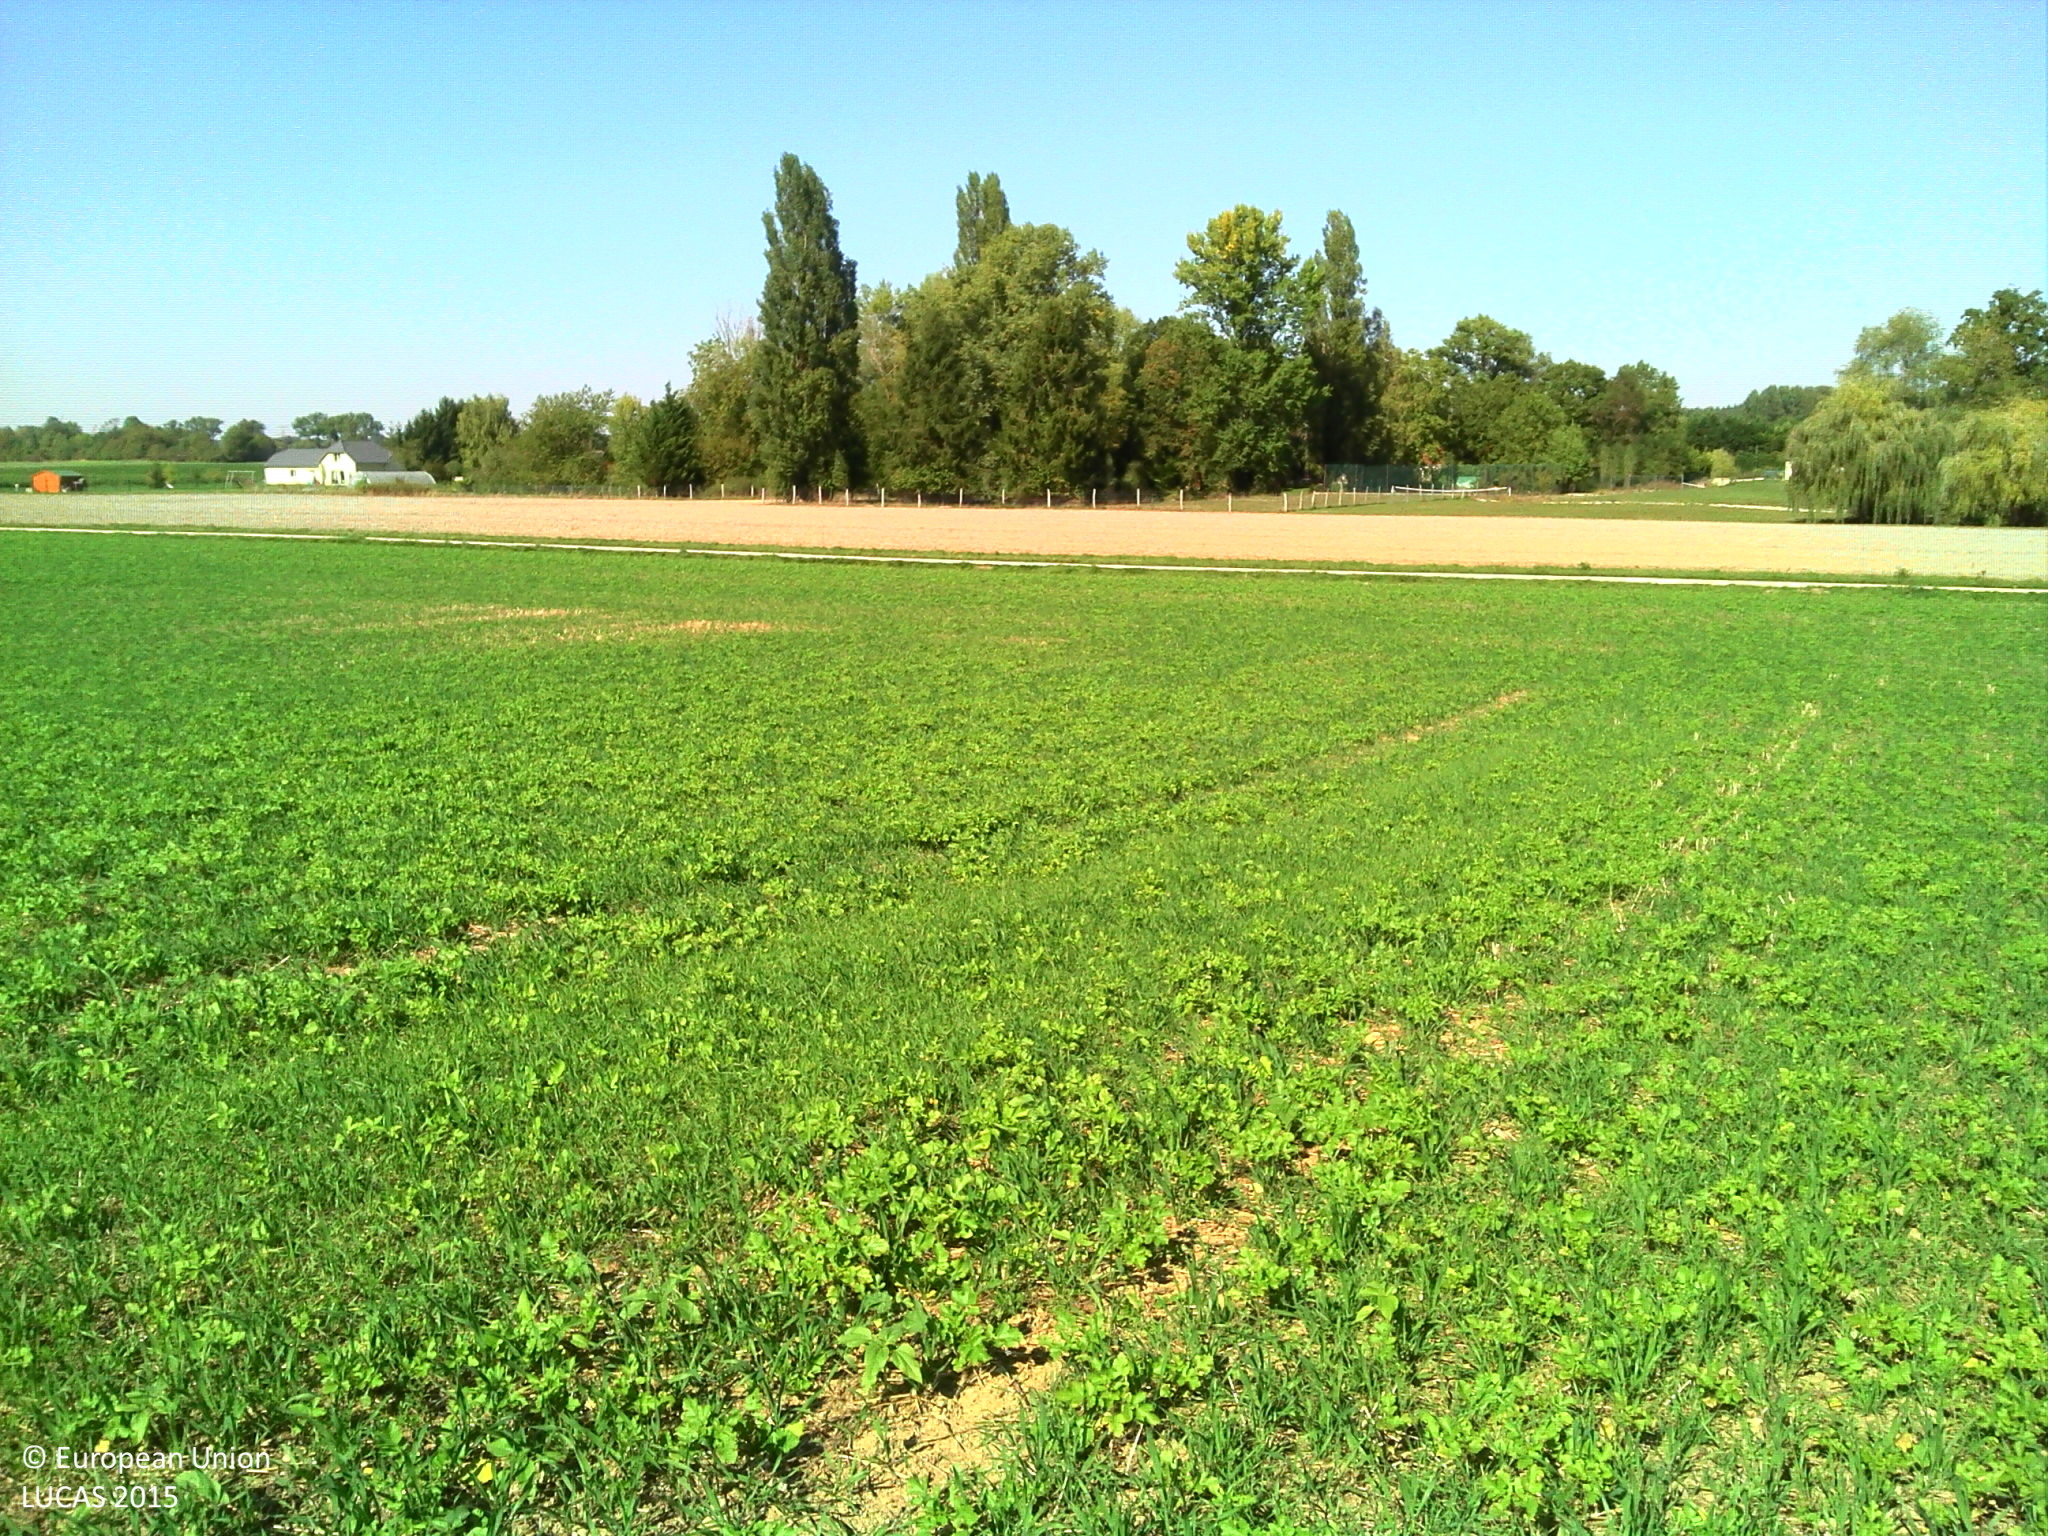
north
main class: Cropland
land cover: Other fibre and oleaginous crops
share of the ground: 50 - 75 %
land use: Agriculture (excluding fallow land and kitchen gardens)
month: September
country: FR
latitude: 48.1461
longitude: 4.2581
